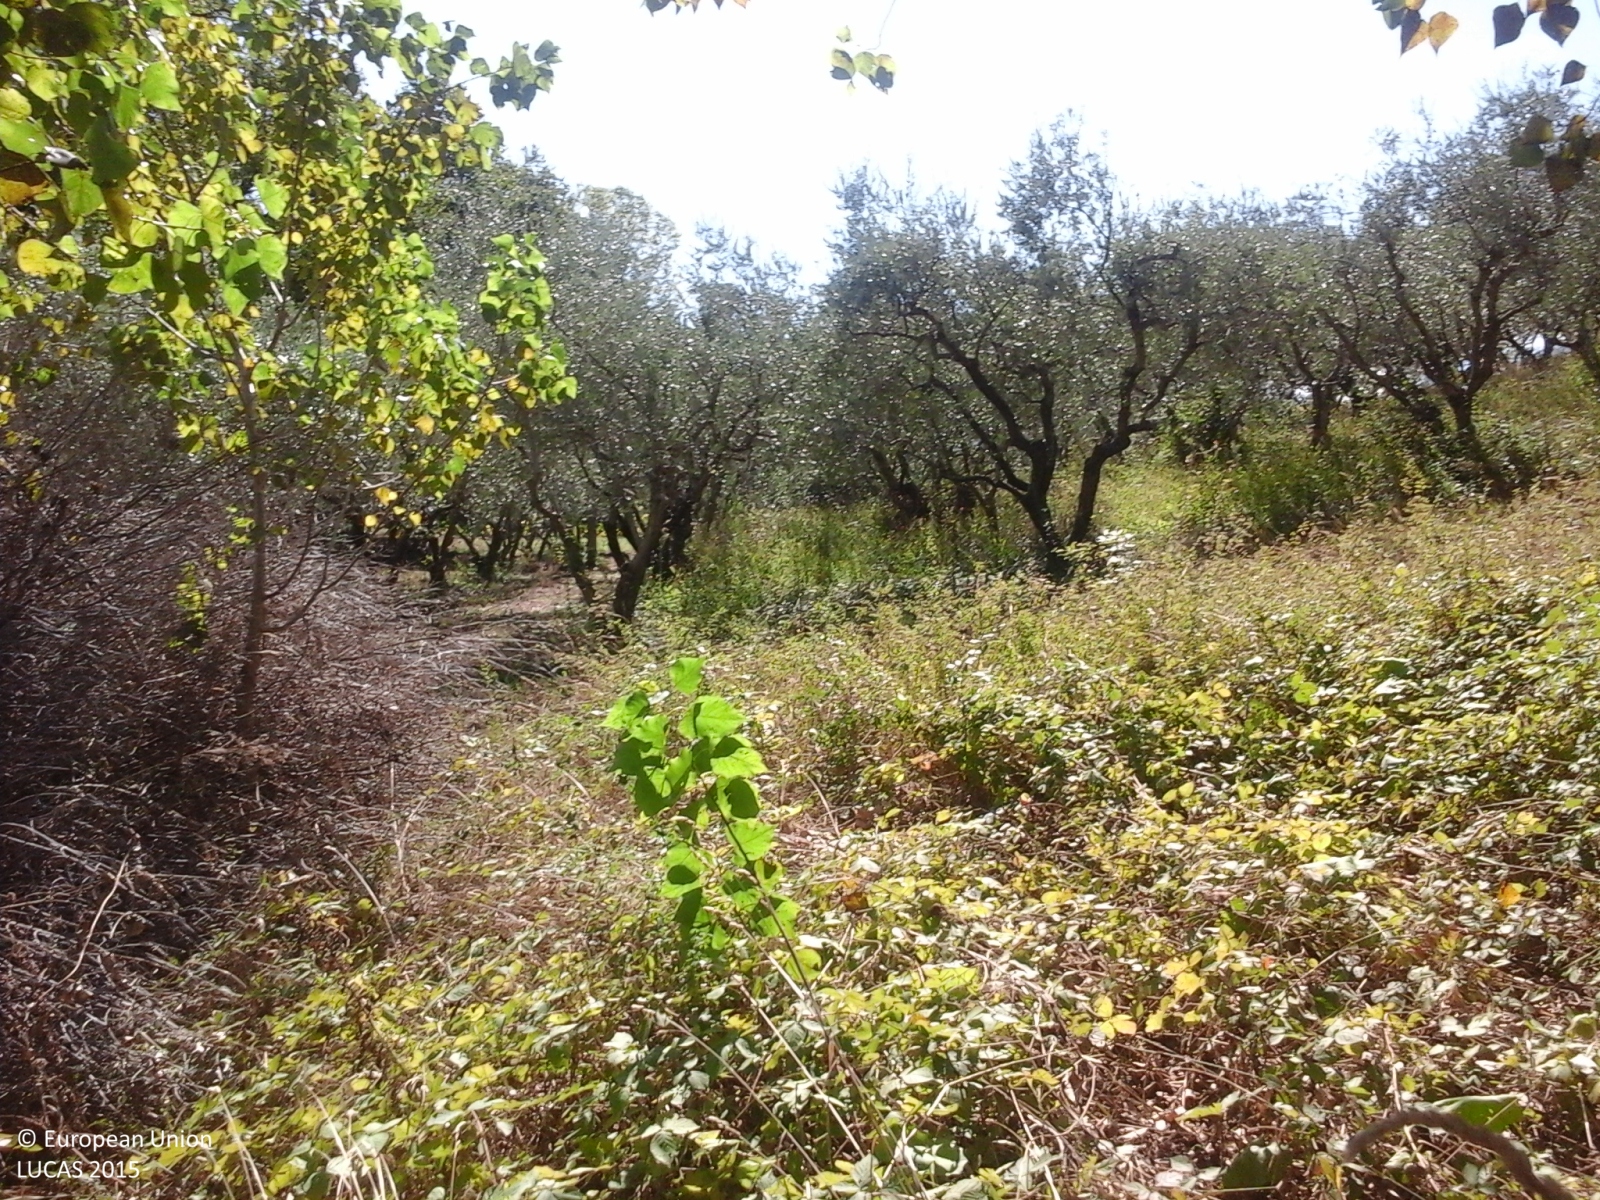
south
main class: Woodland
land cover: Broadleaved woodland
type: thermophilous deciduous forest
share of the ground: > 75 %
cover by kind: broadleaved forest trees 100 %
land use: Forestry
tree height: > 5 m
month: September
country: IT
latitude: 43.7248
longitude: 13.1580
